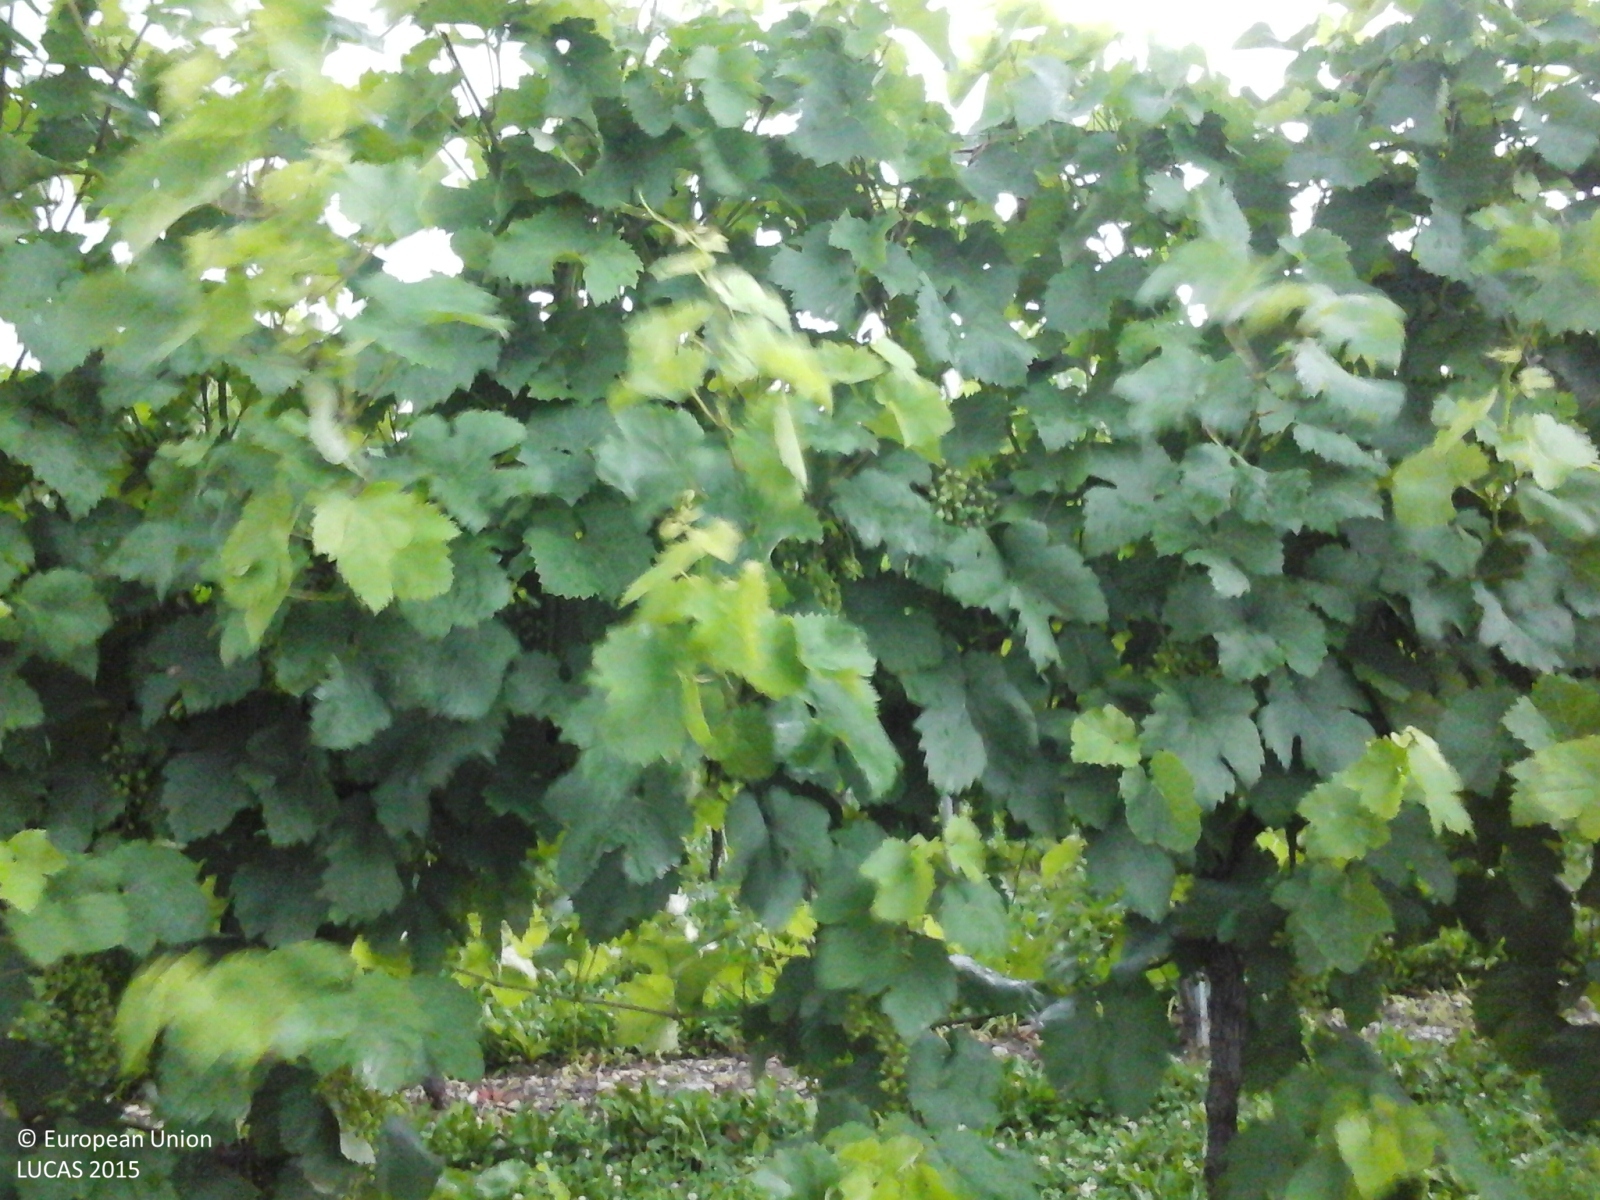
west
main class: Cropland
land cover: Vineyards
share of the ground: < 10 %
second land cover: Grassland without tree/shrub cover
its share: > 75 %
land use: Agriculture (excluding fallow land and kitchen gardens)
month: June
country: IT
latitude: 45.8393
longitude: 12.3272
